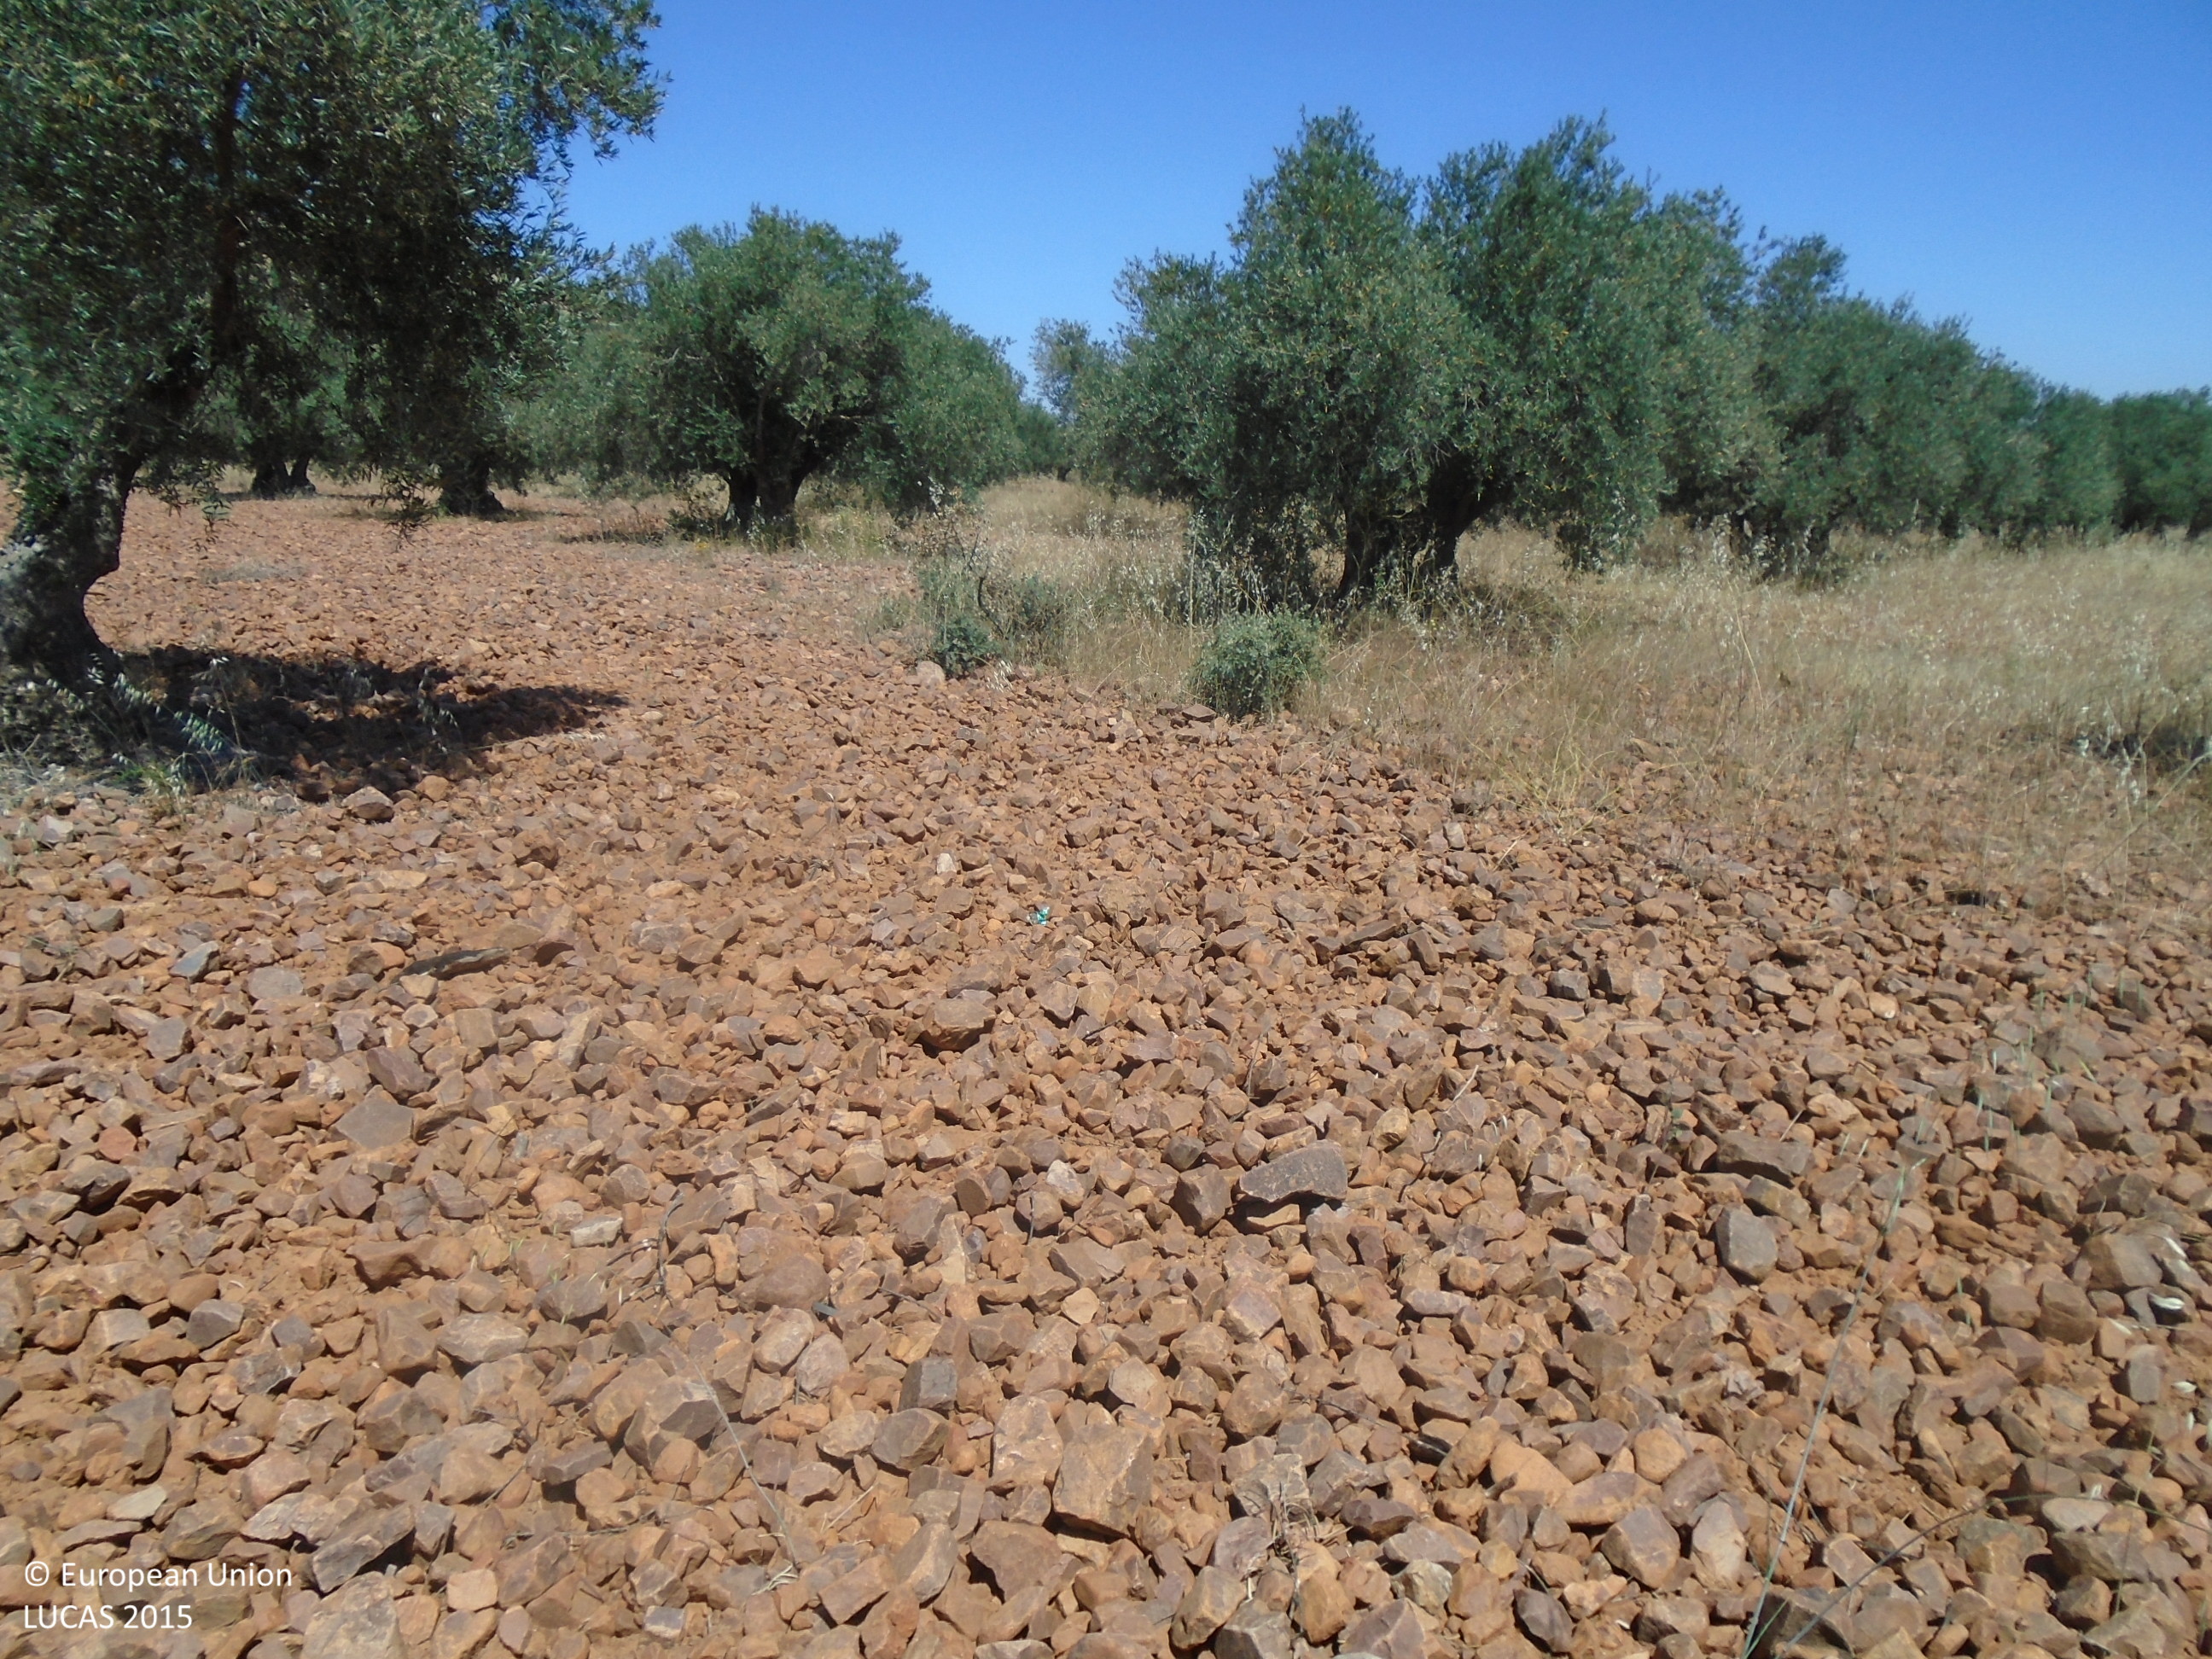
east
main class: Cropland
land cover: Olive groves
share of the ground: 10 - 25 %
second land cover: Other bare soil
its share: > 75 %
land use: Agriculture (excluding fallow land and kitchen gardens)
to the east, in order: Olive groves; Other bare soil; Grass margins; Olive groves; Grass margins; Olive groves
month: June
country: ES
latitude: 39.4299
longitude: -3.6976
